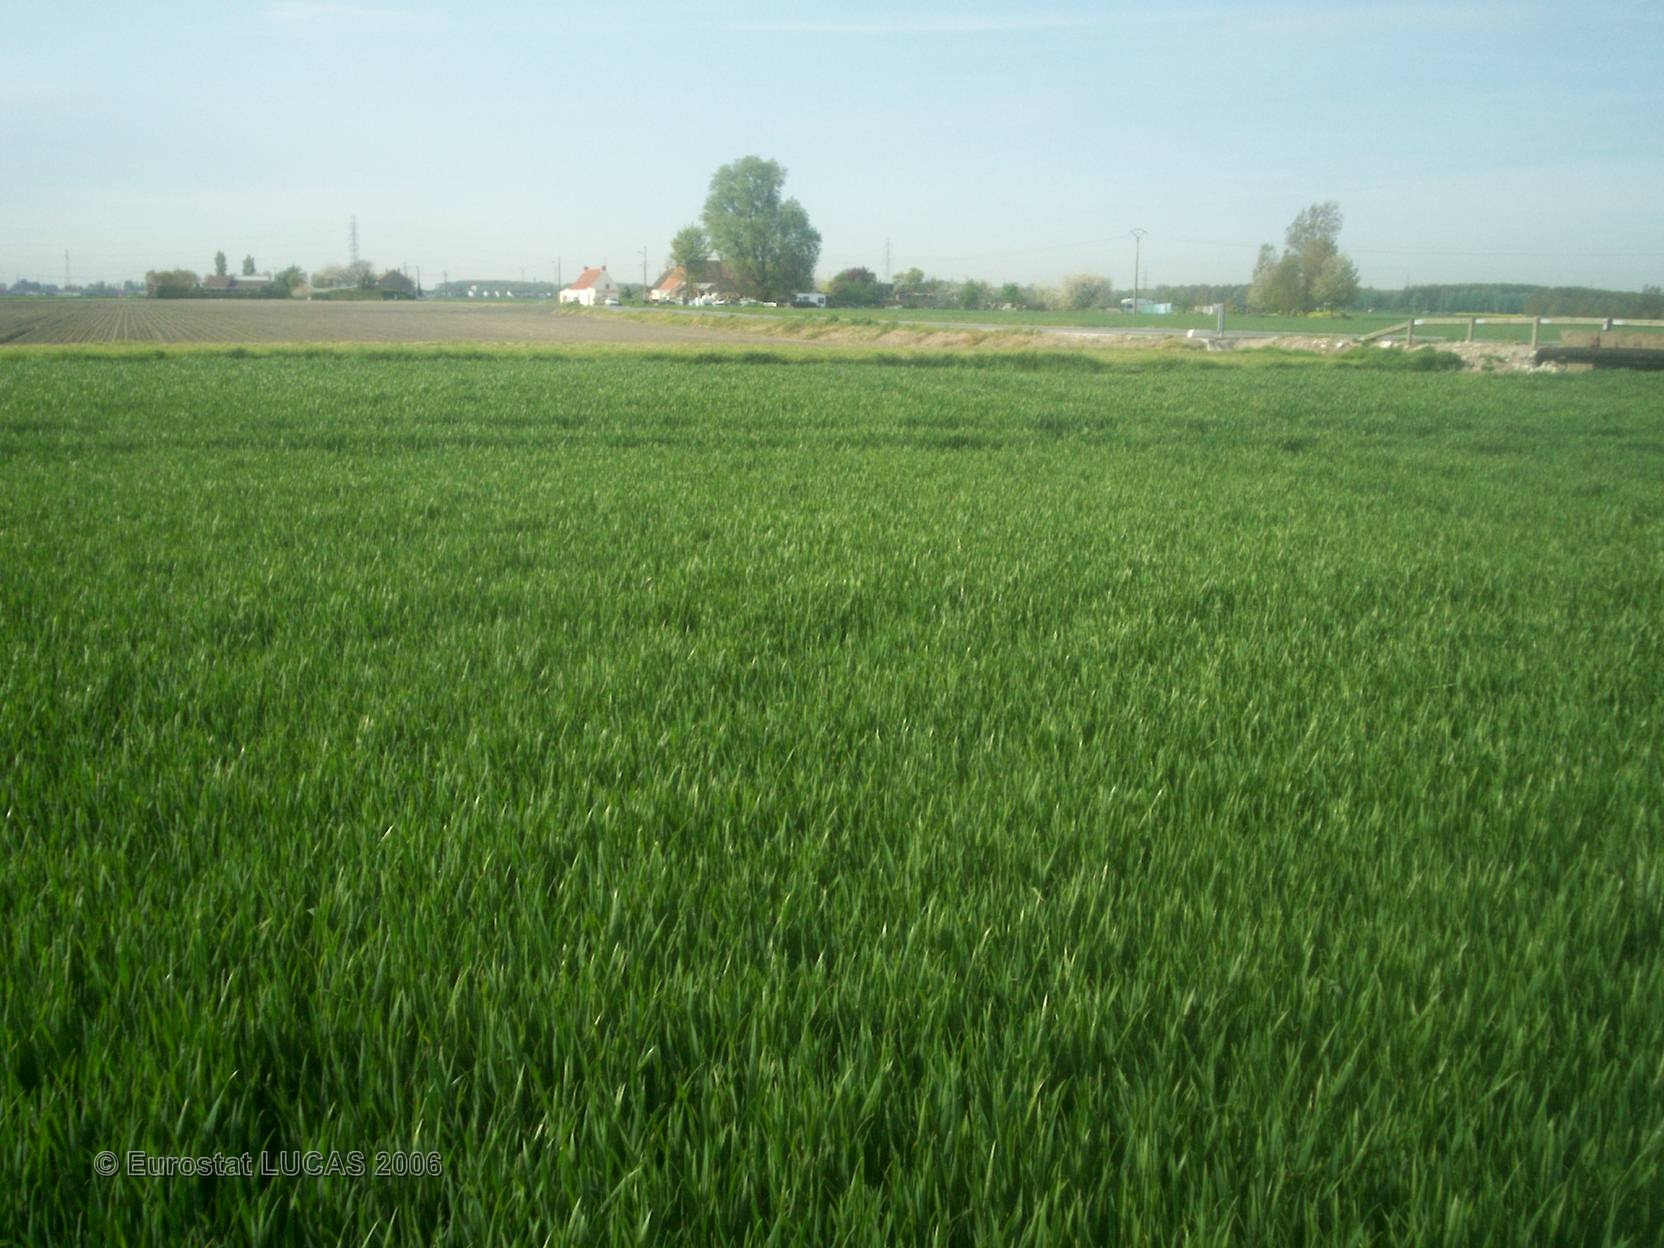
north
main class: Cropland
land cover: Common wheat
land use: Agriculture (excluding fallow land and kitchen gardens)
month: May
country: FR
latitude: 50.9776
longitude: 2.3952
